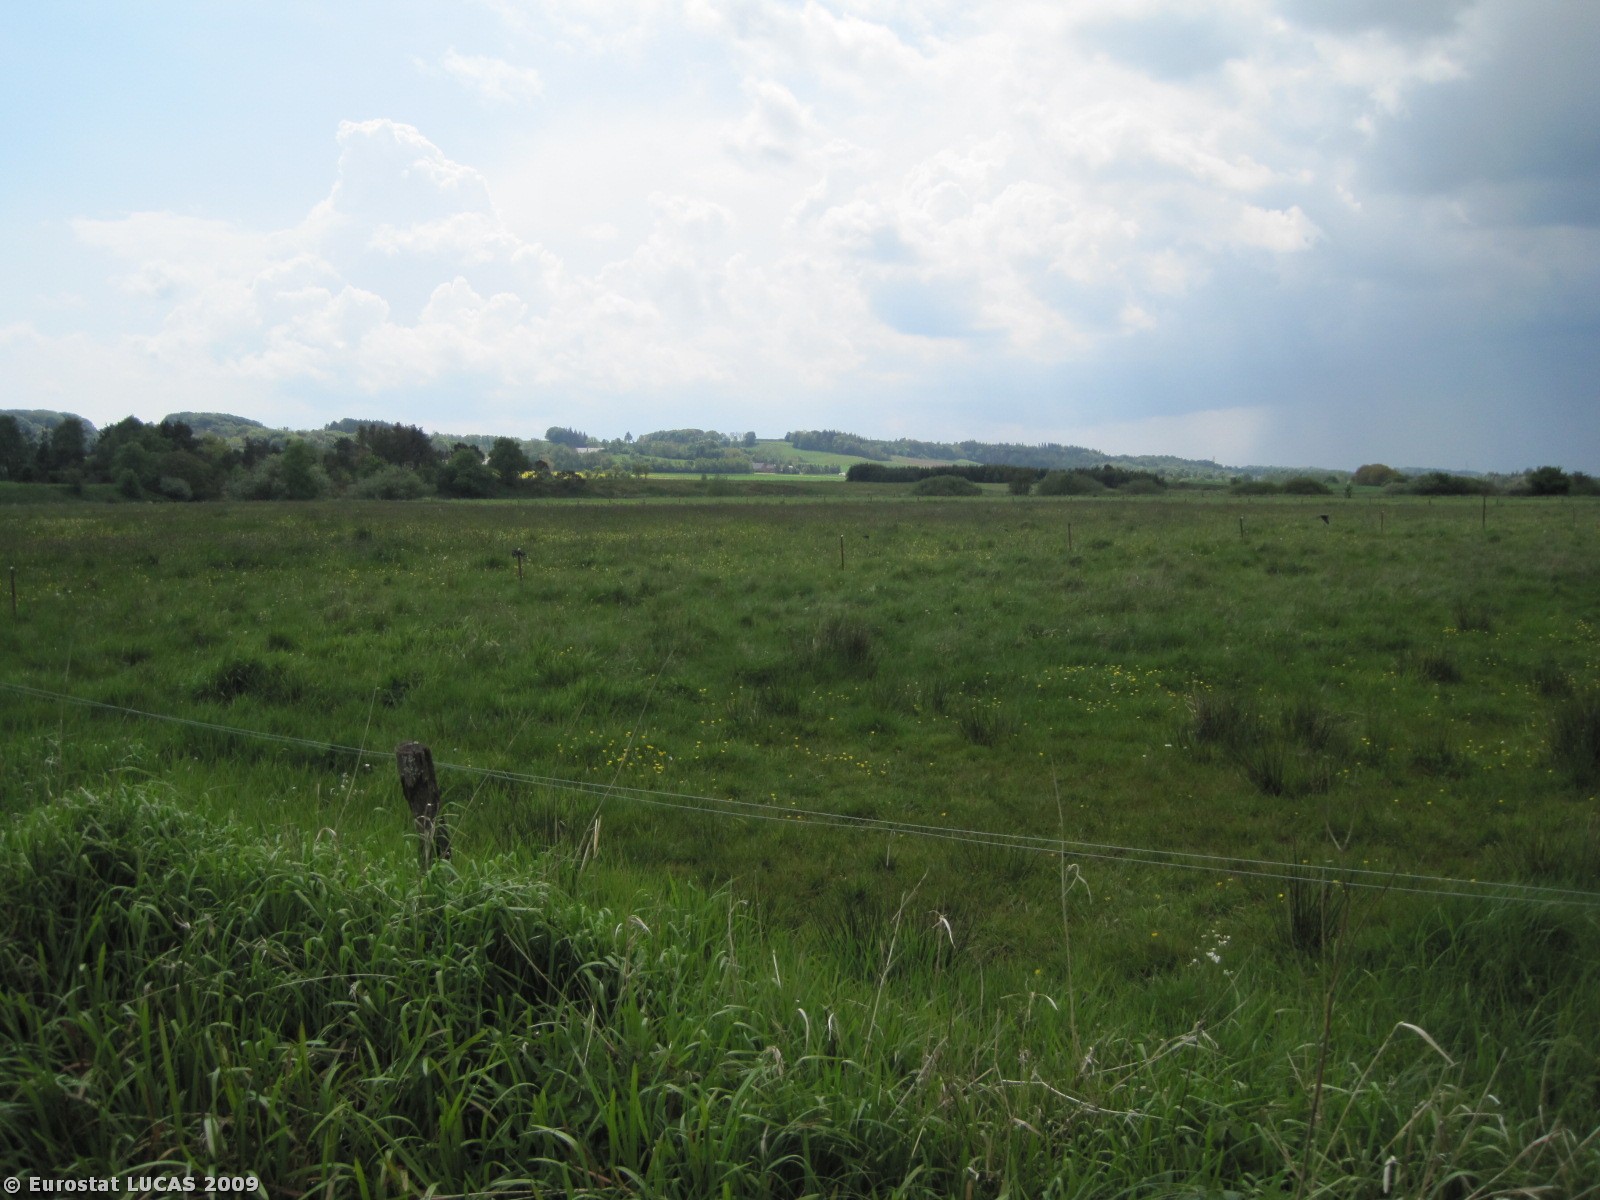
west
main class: Wetlands
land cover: Inland marshes
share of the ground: > 75 %
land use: Unused
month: May
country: DK
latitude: 56.3852
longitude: 9.7250
